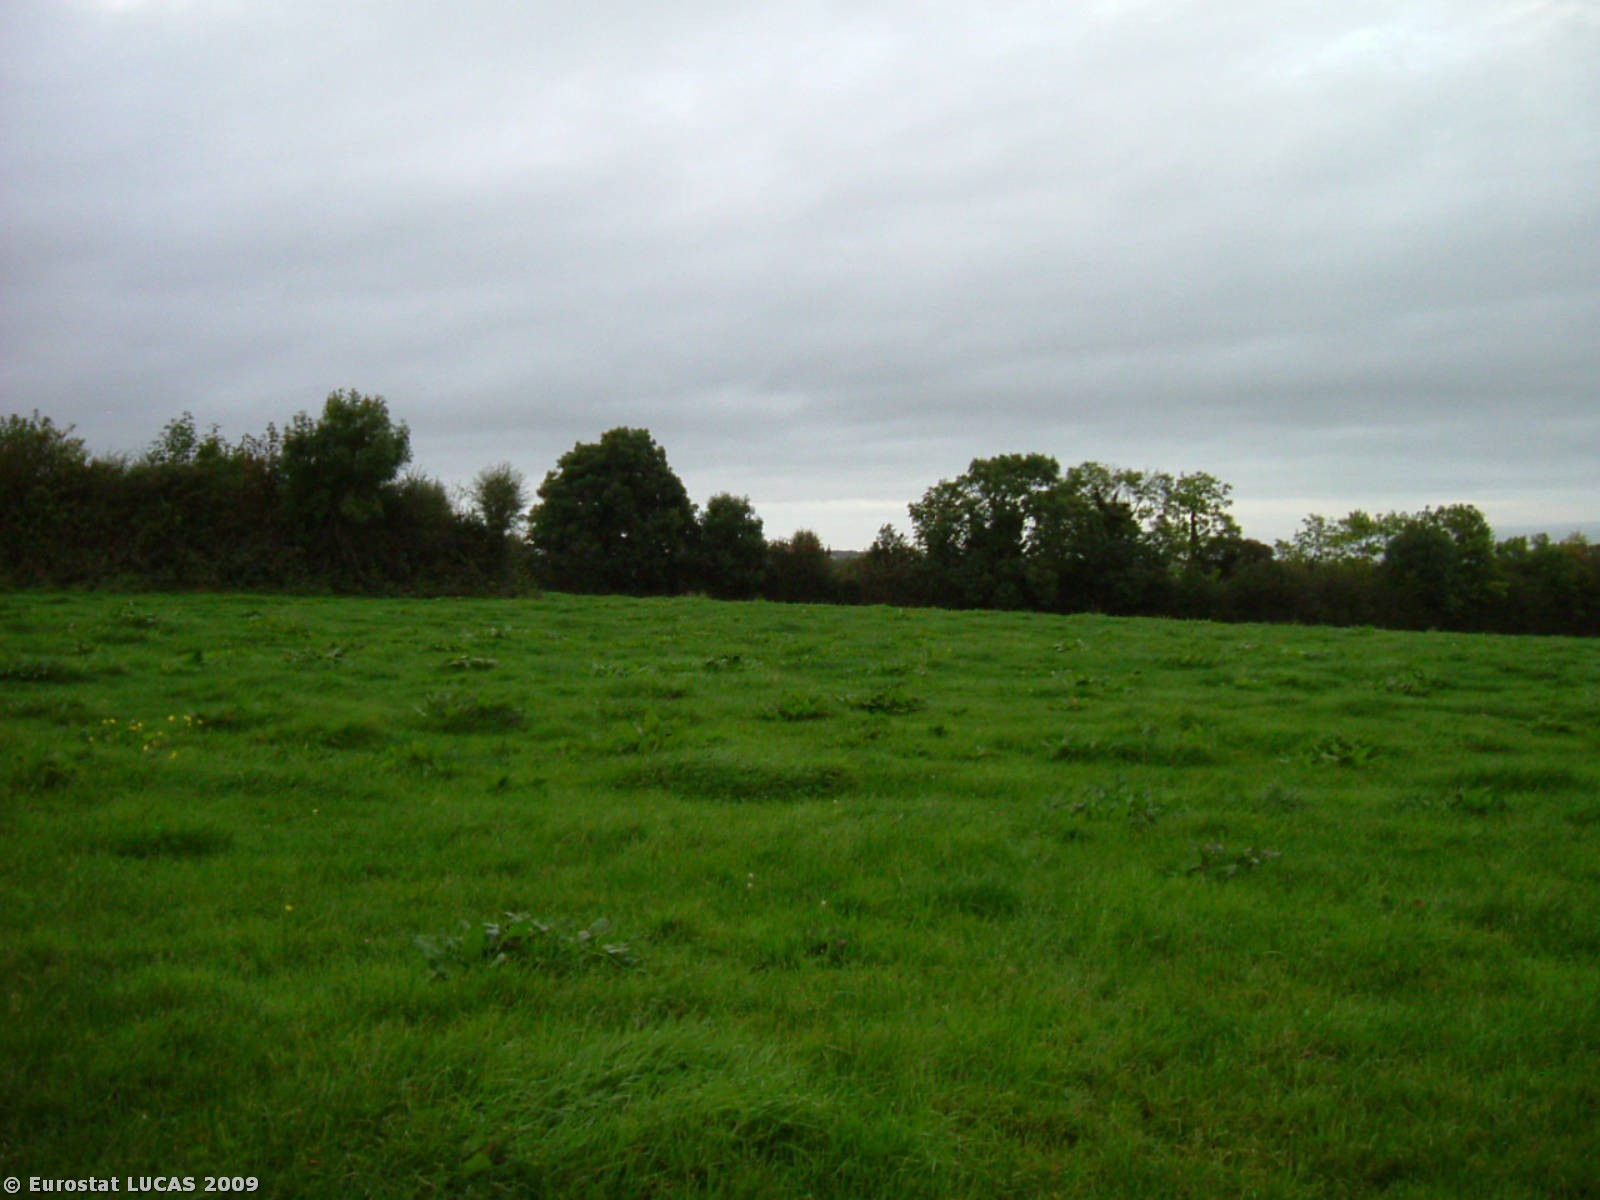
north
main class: Grassland
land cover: Grassland without tree/shrub cover
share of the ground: > 75 %
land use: Agriculture (excluding fallow land and kitchen gardens)
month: September
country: IE
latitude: 52.8906
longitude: -7.8424
